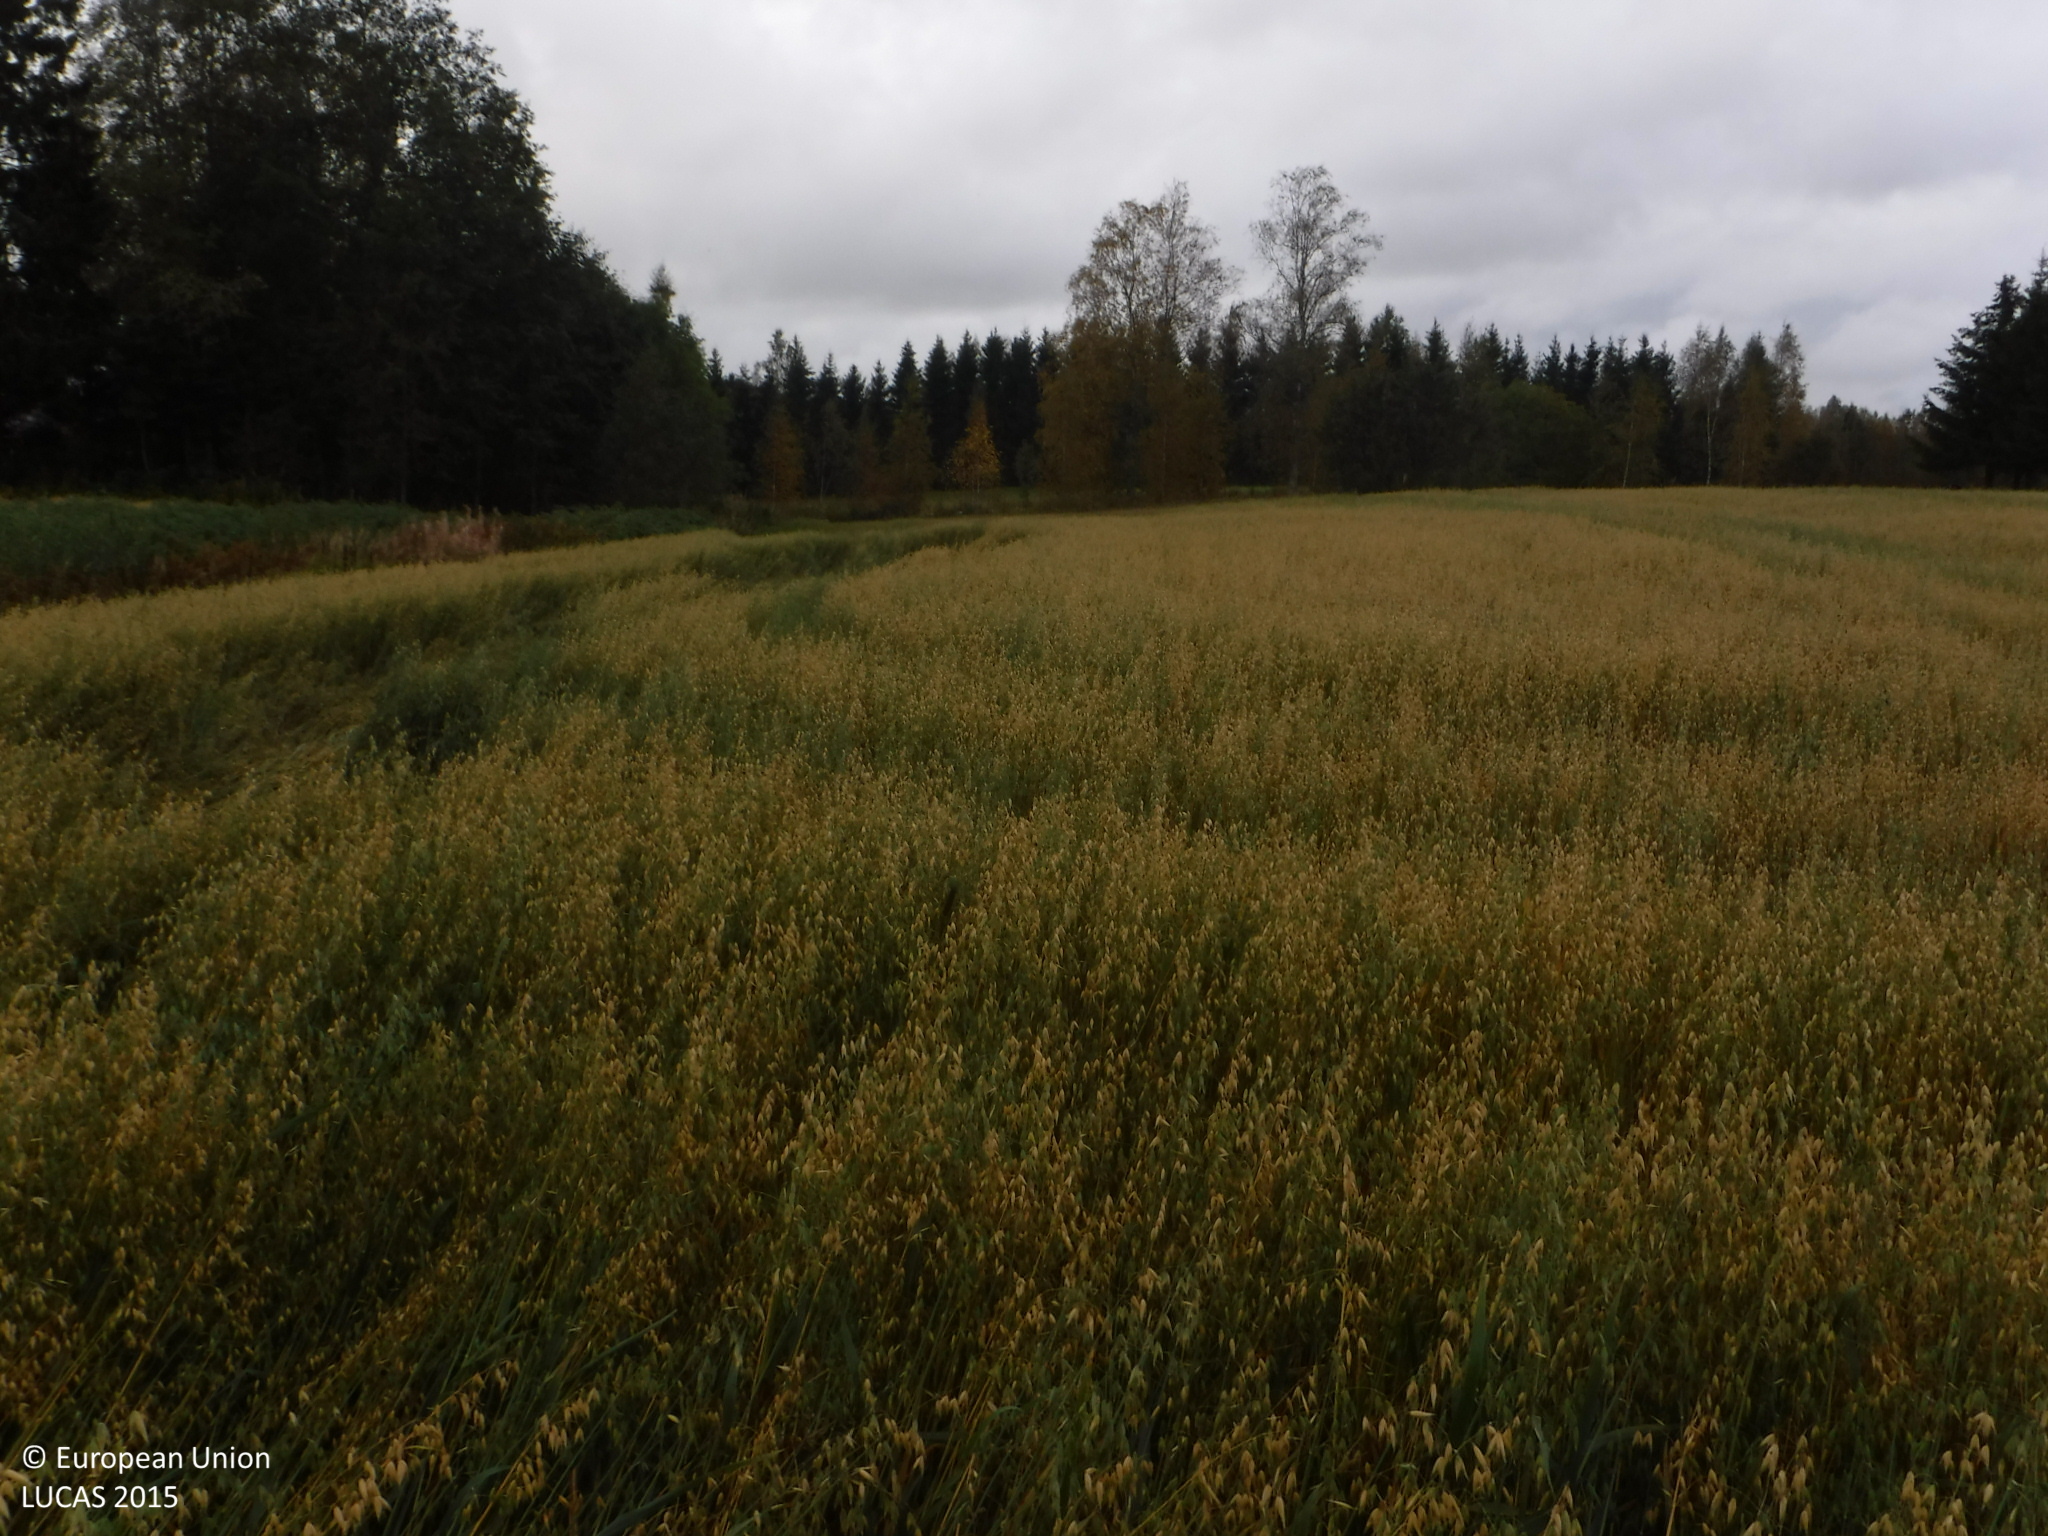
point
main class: Cropland
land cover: Oats
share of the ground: > 75 %
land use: Agriculture (excluding fallow land and kitchen gardens)
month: September
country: FI
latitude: 61.9997
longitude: 22.2572
